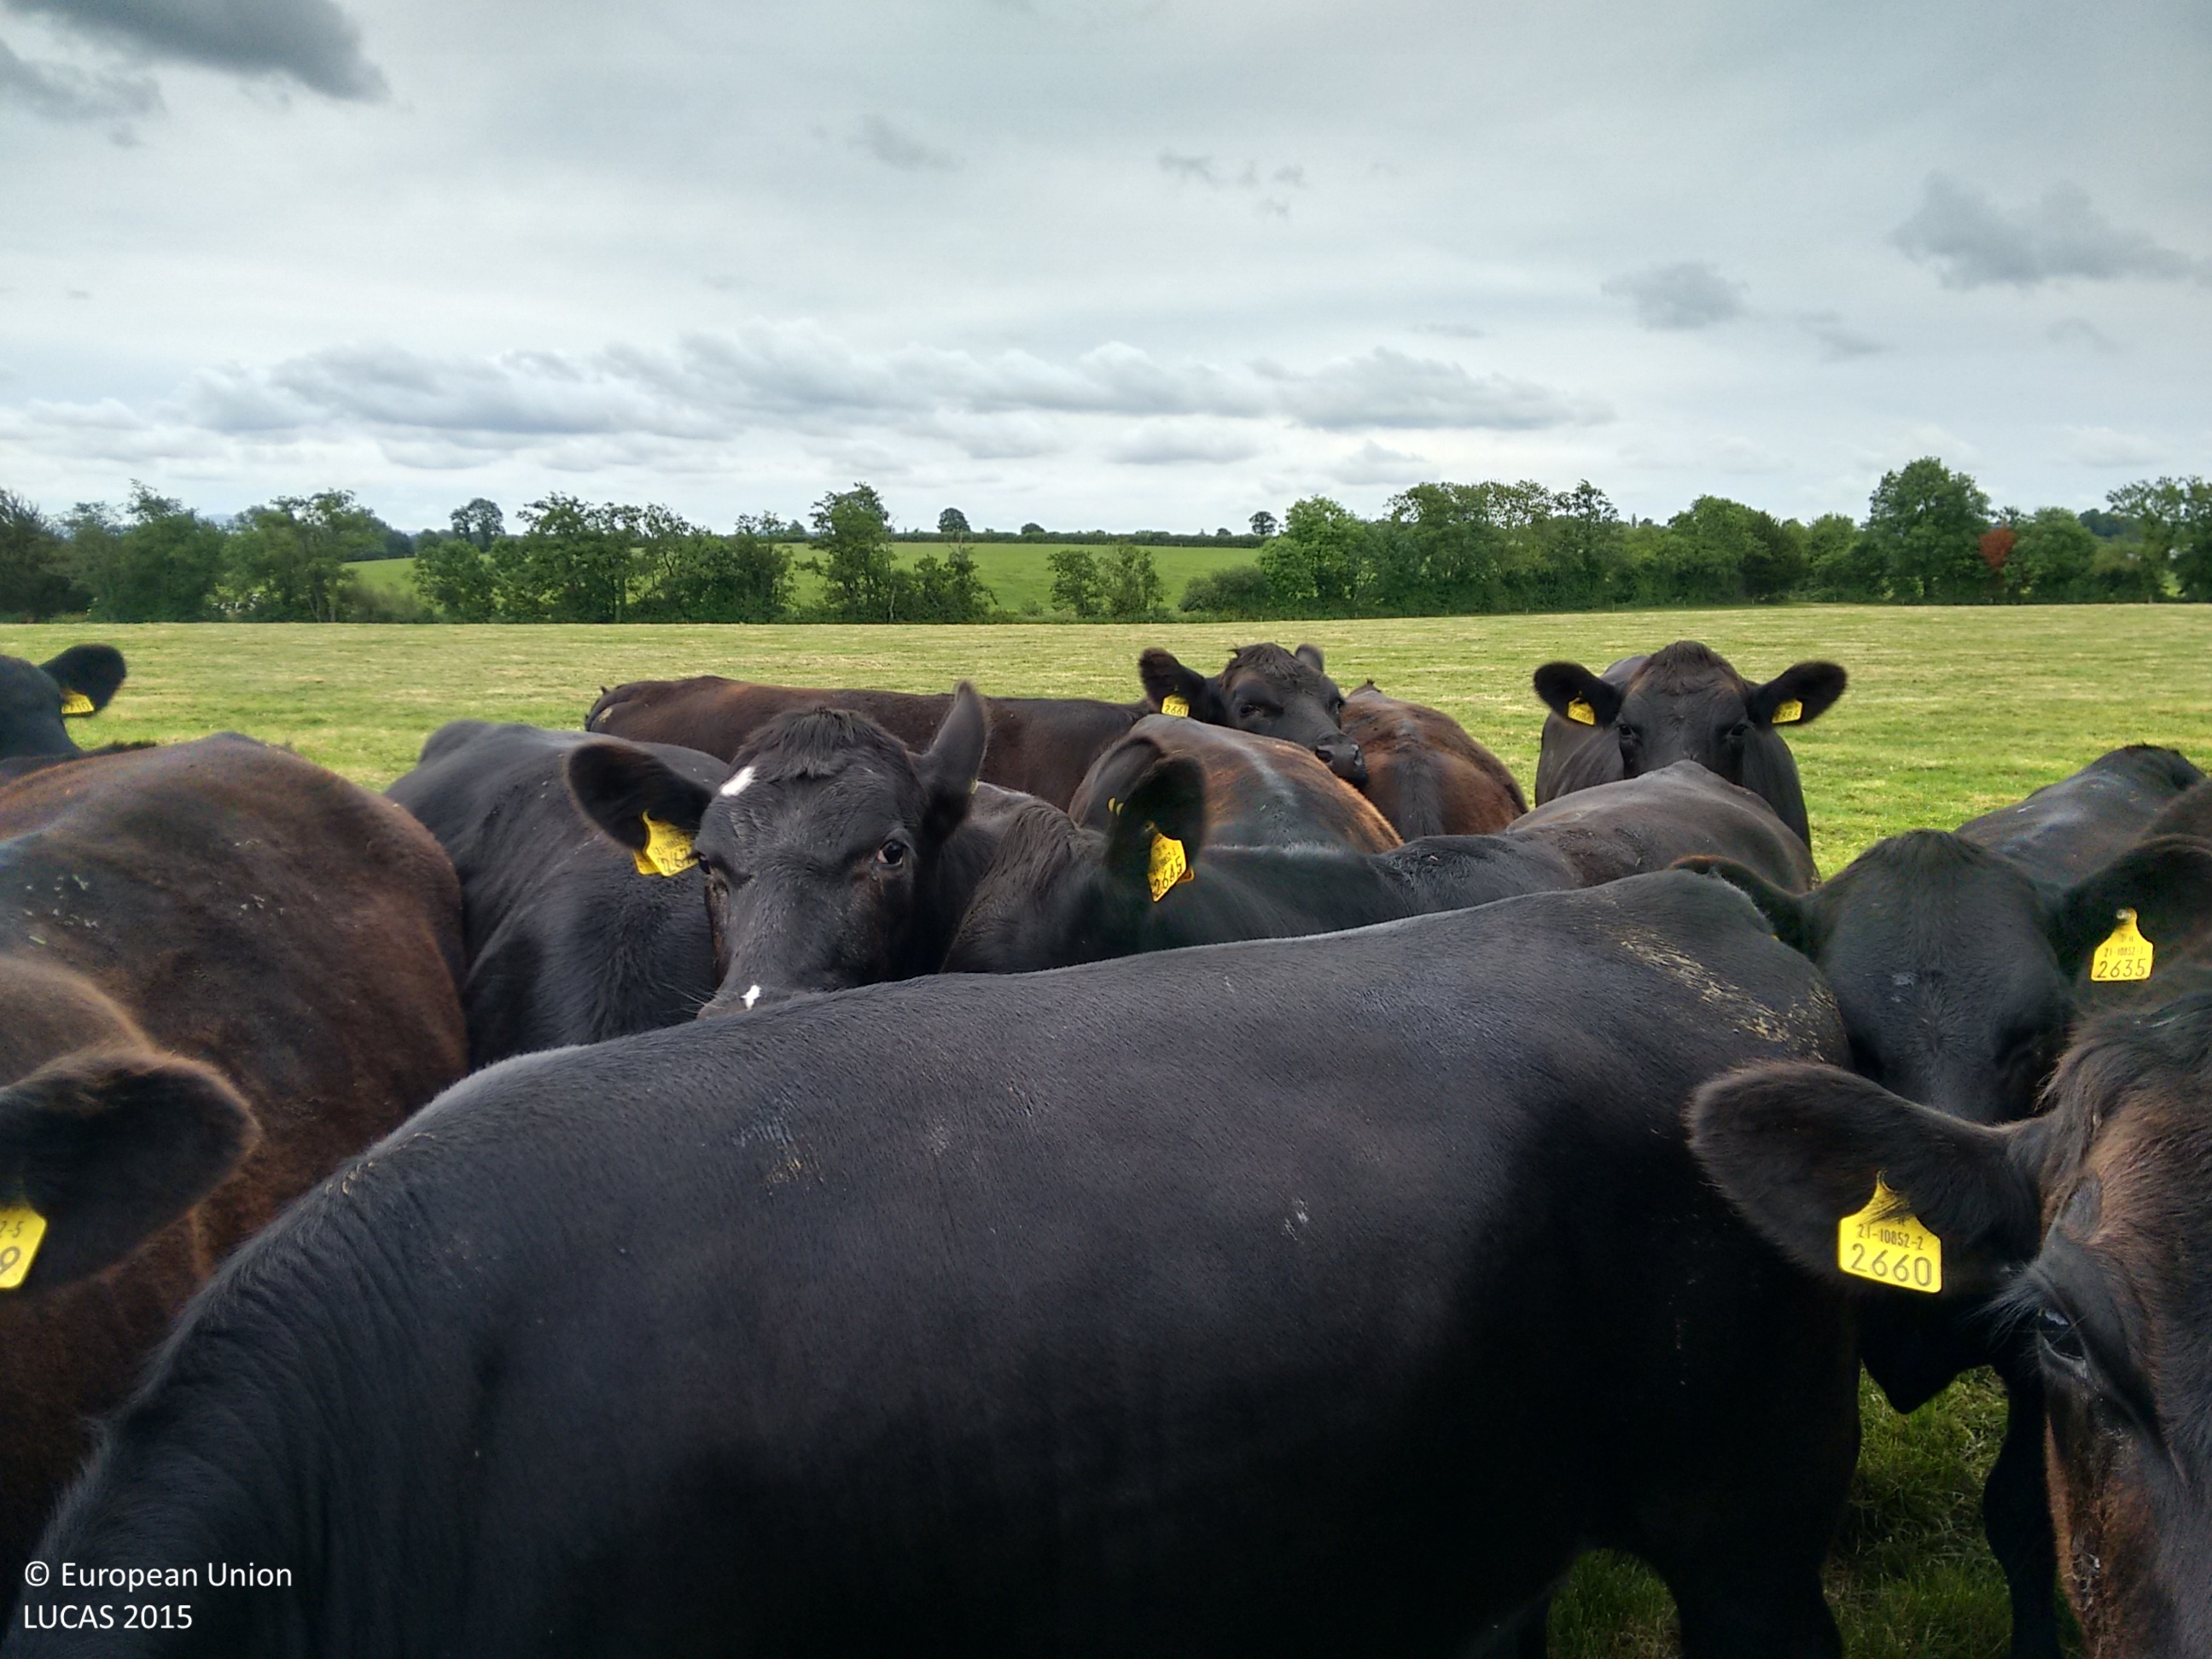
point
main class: Grassland
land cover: Grassland without tree/shrub cover
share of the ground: > 75 %
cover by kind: herbaceous plants 100 %
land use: Agriculture (excluding fallow land and kitchen gardens)
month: July
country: IE
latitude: 52.5387
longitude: -7.3603
